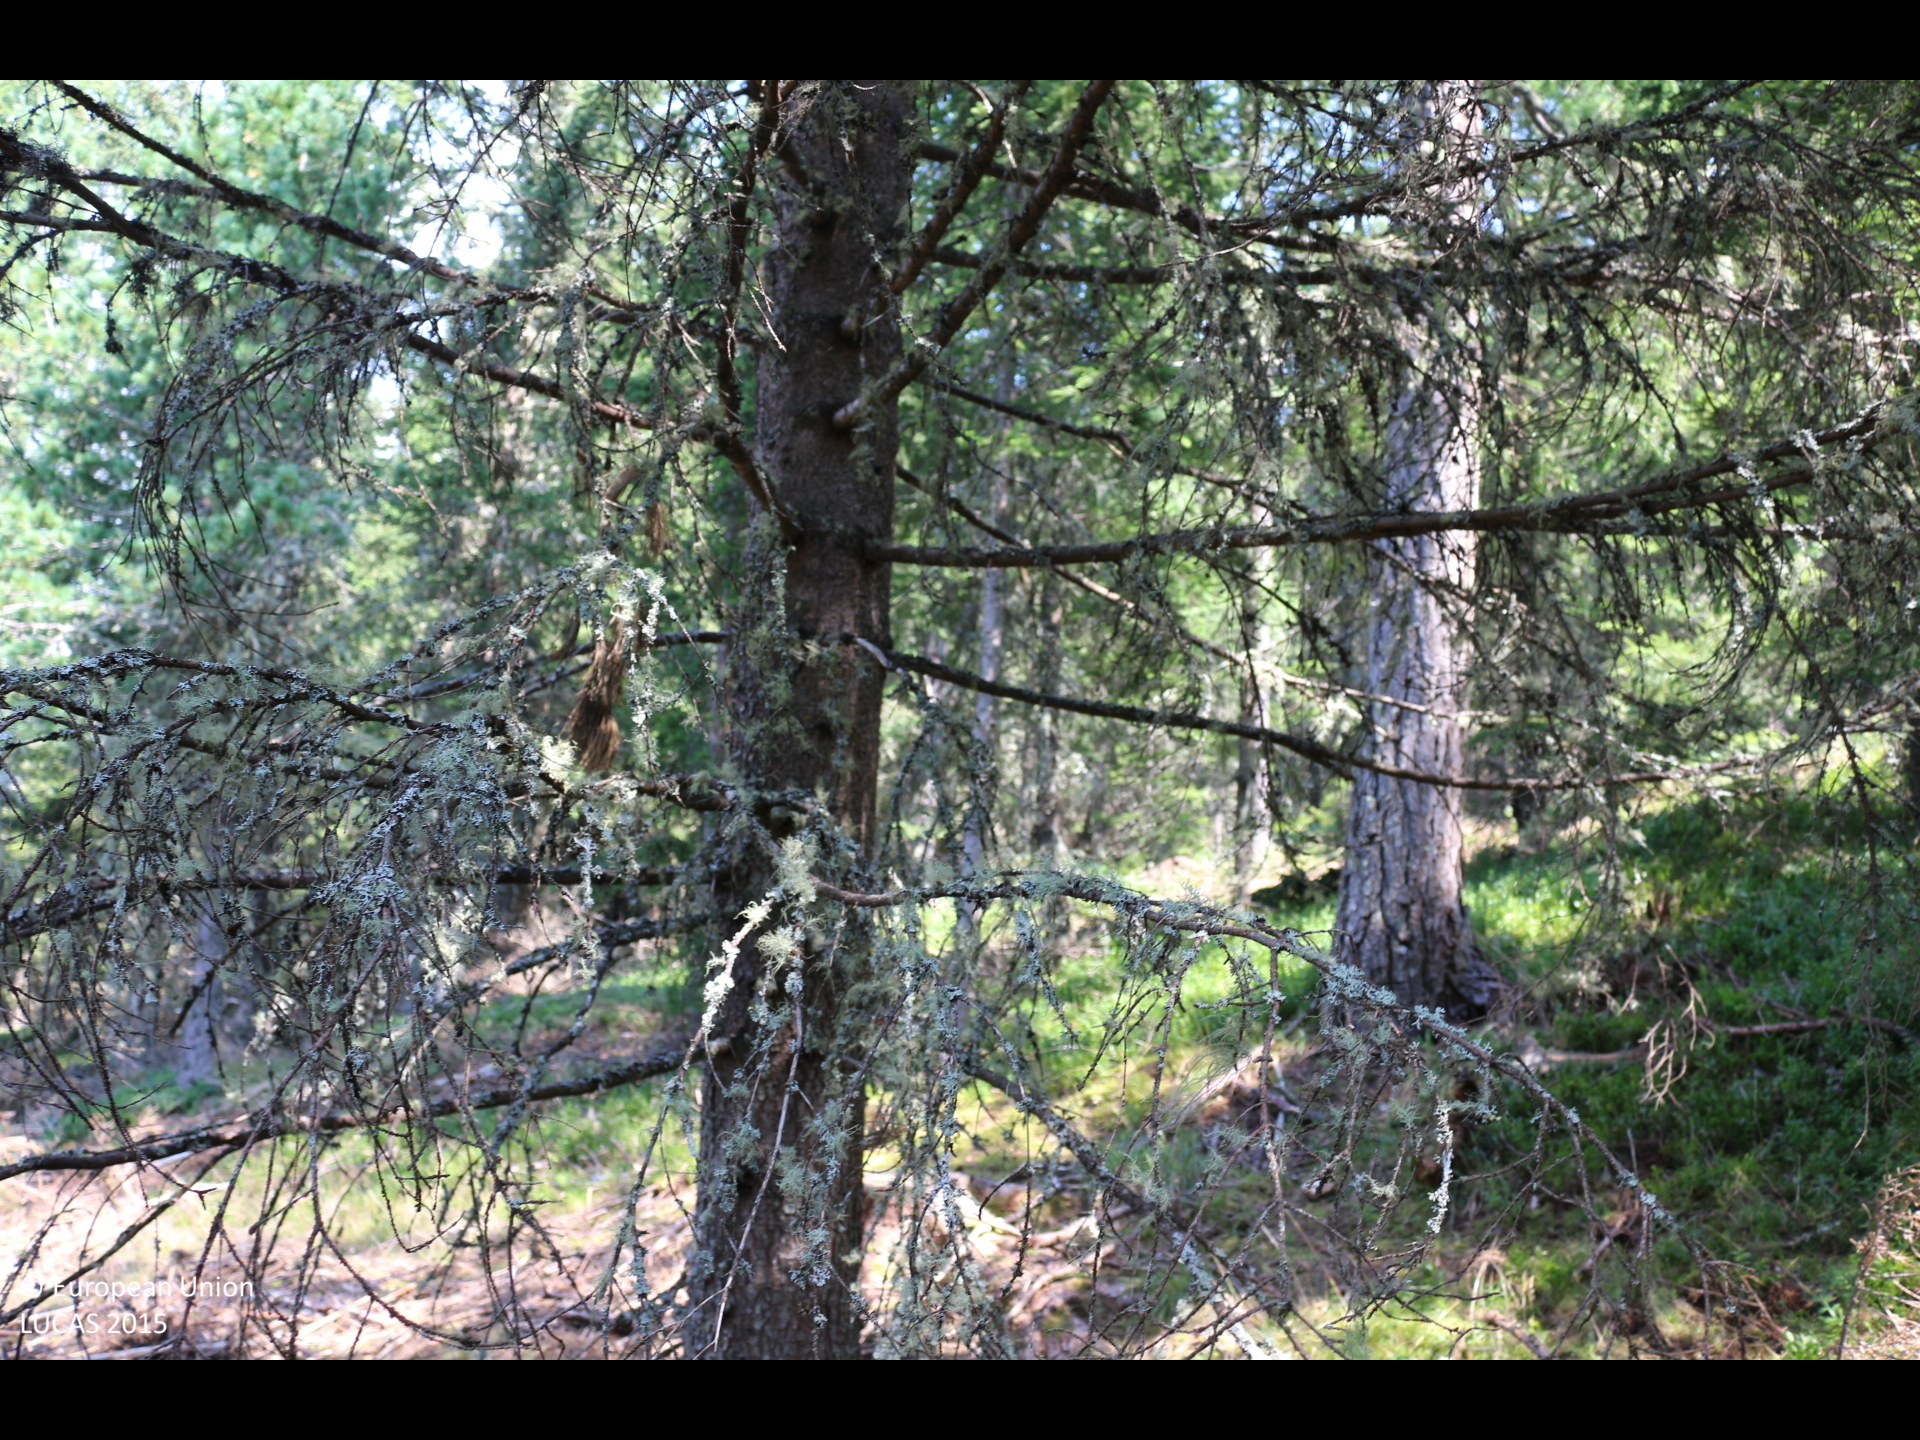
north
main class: Woodland
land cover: Spruce dominated coniferous woodland
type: alpine coniferous forest
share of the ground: > 75 %
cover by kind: coniferous forest trees 90 %, herbaceous plants 10 %
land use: Forestry
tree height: > 5 m
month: August
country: AT
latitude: 46.8715
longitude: 13.9992
